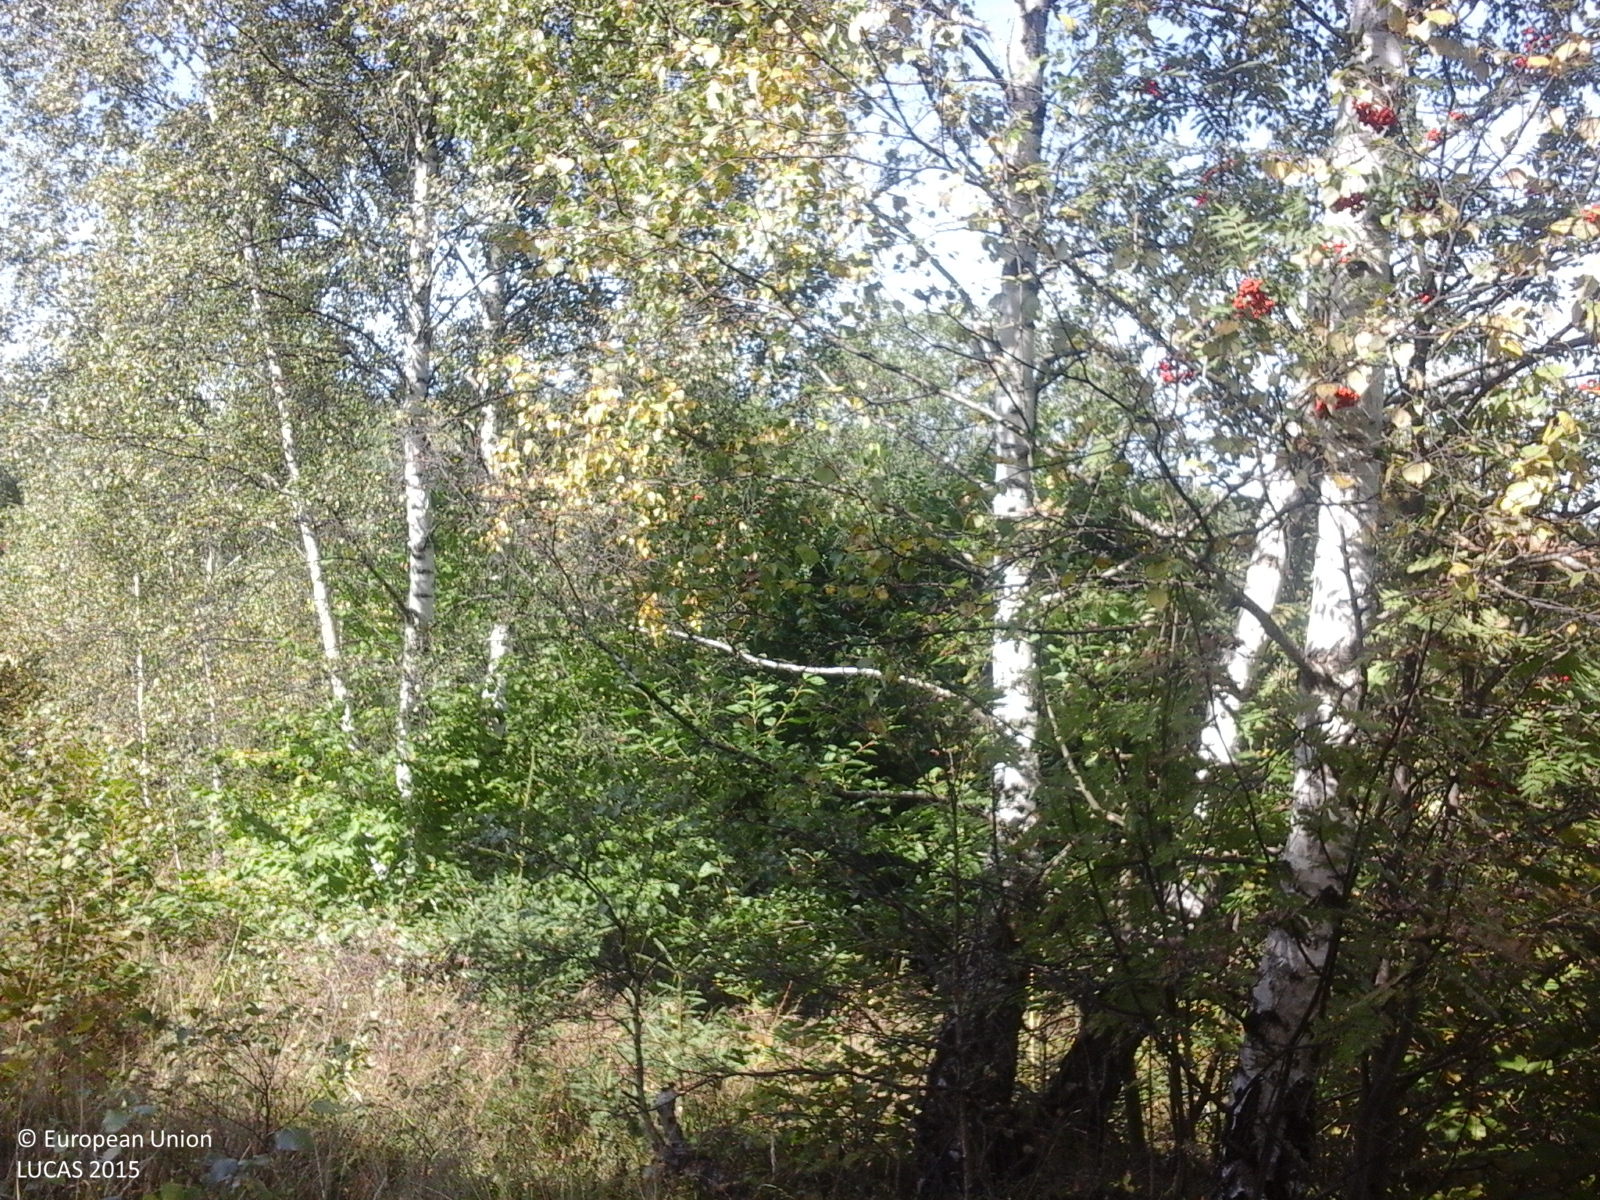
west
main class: Woodland
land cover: Spruce dominated mixed woodland
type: alpine coniferous forest
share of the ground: > 75 %
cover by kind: coniferous forest trees 50 %, broadleaved forest trees 40 %, shrubs 5 %, herbaceous plants 5 %
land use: Forestry
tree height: > 5 m
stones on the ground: < 10 %
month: September
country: RO
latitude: 46.7290
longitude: 23.0818
